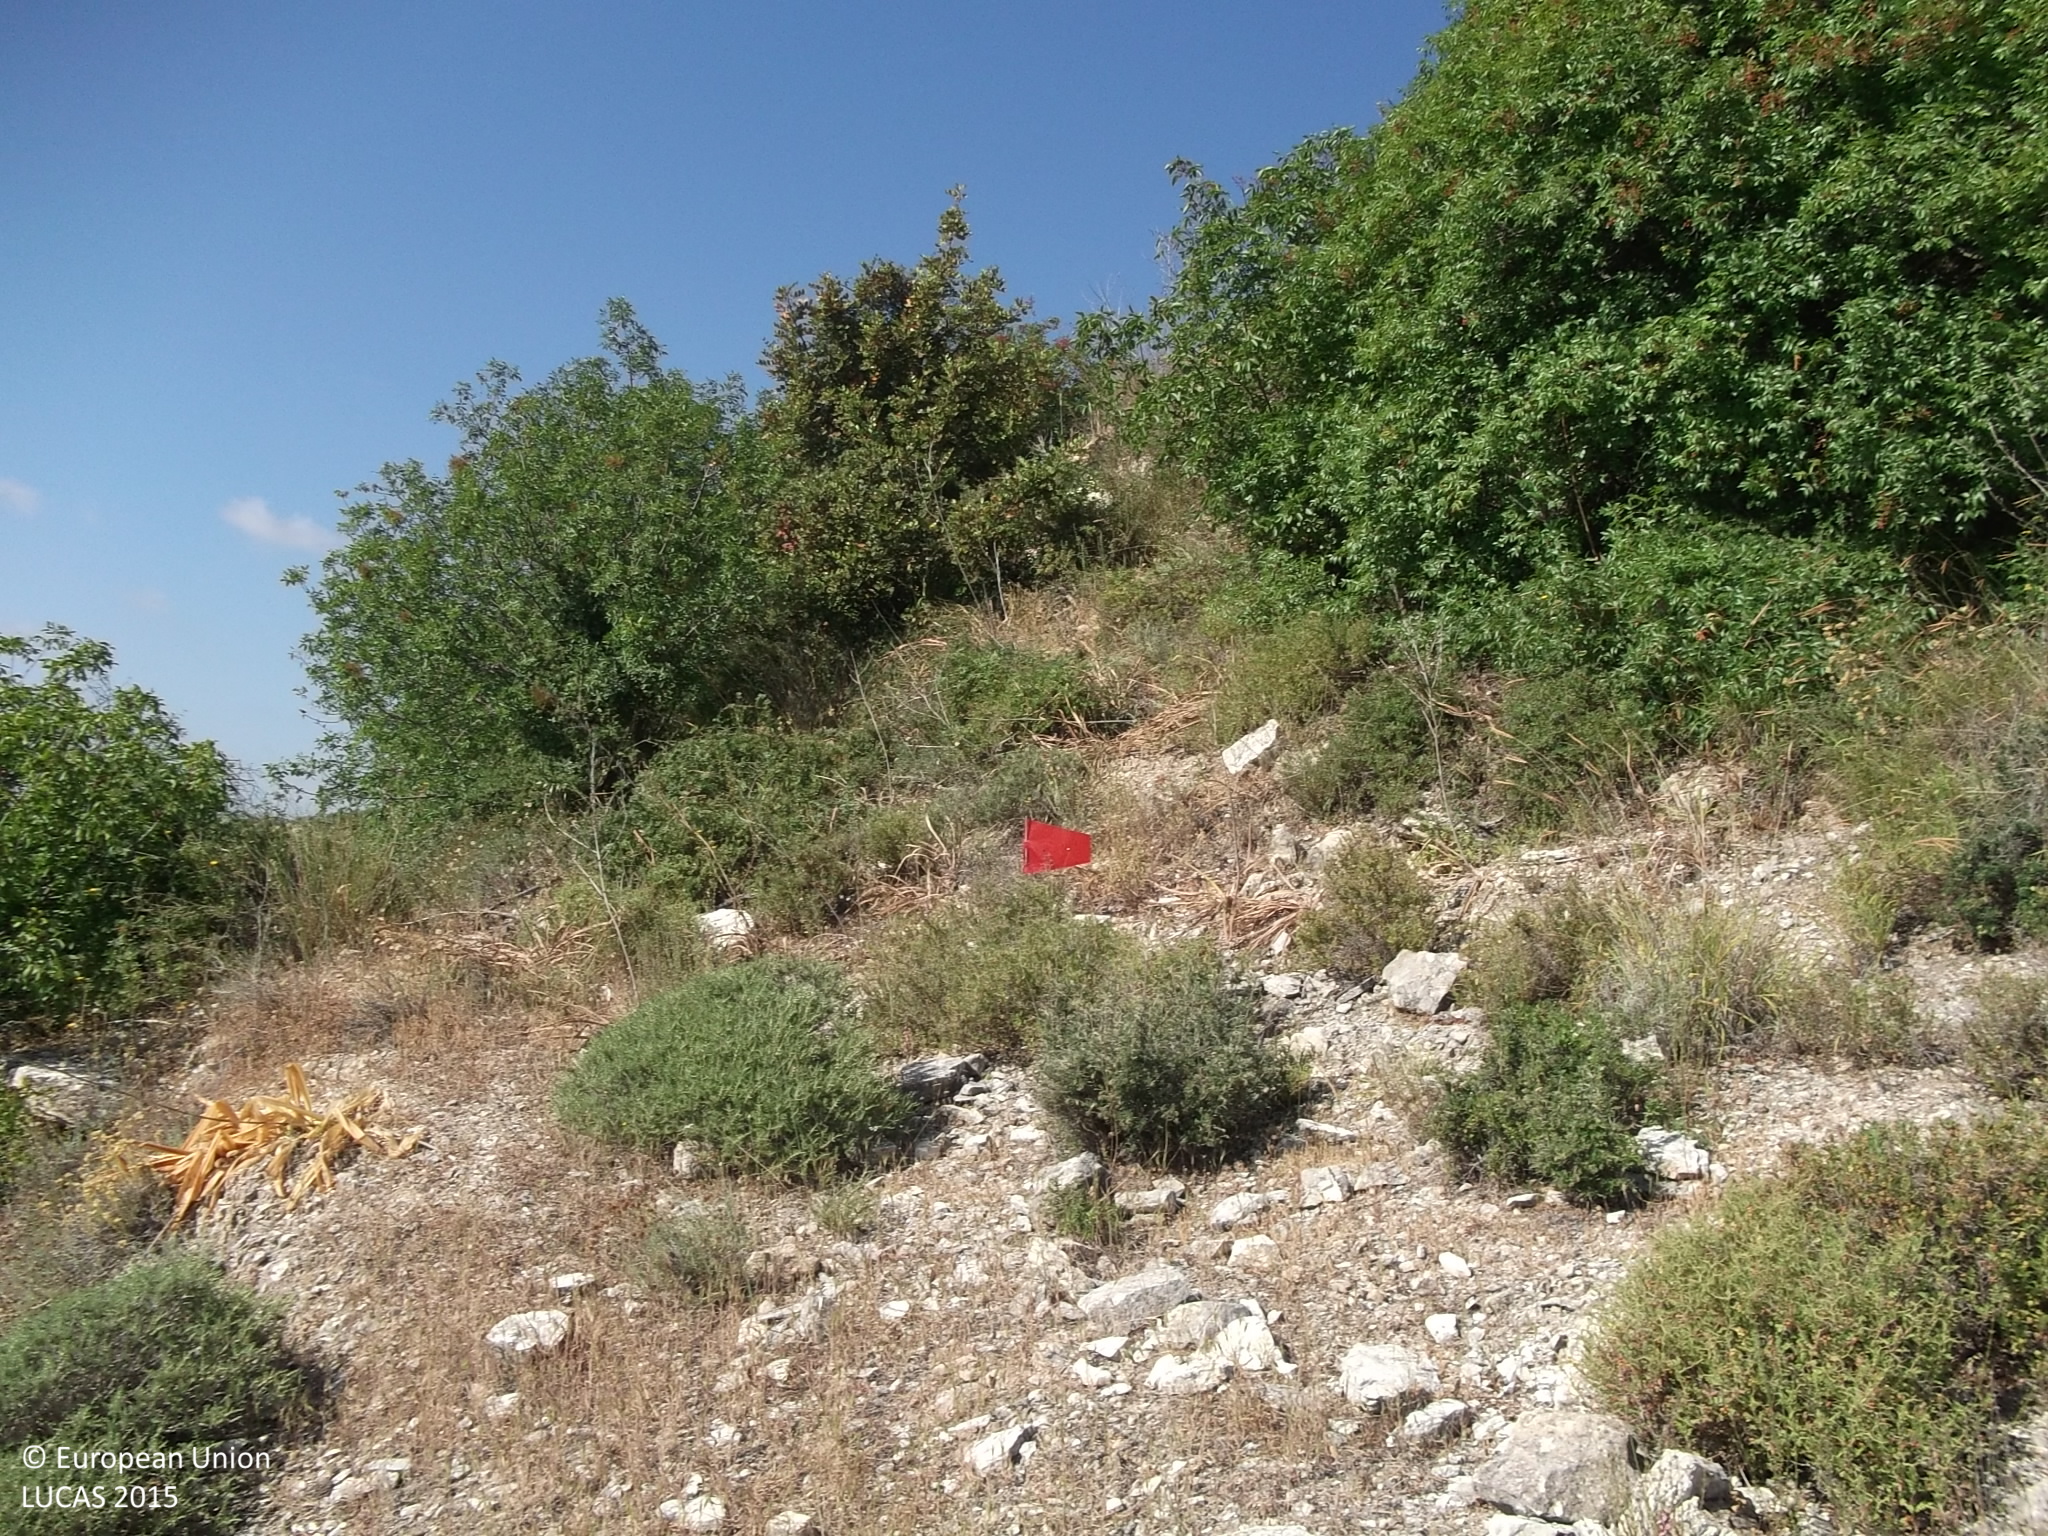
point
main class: Shrubland
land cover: Shrubland with sparse tree cover
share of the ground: 50 - 75 %
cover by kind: shrubs 70 %, herbaceous plants 15 %, unconsolidated bare surface 10 %, broadleaved forest trees 5 %
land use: Semi-natural and natural areas not in use
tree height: < 5 m
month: May
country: CY
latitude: 34.8019
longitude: 32.5240
